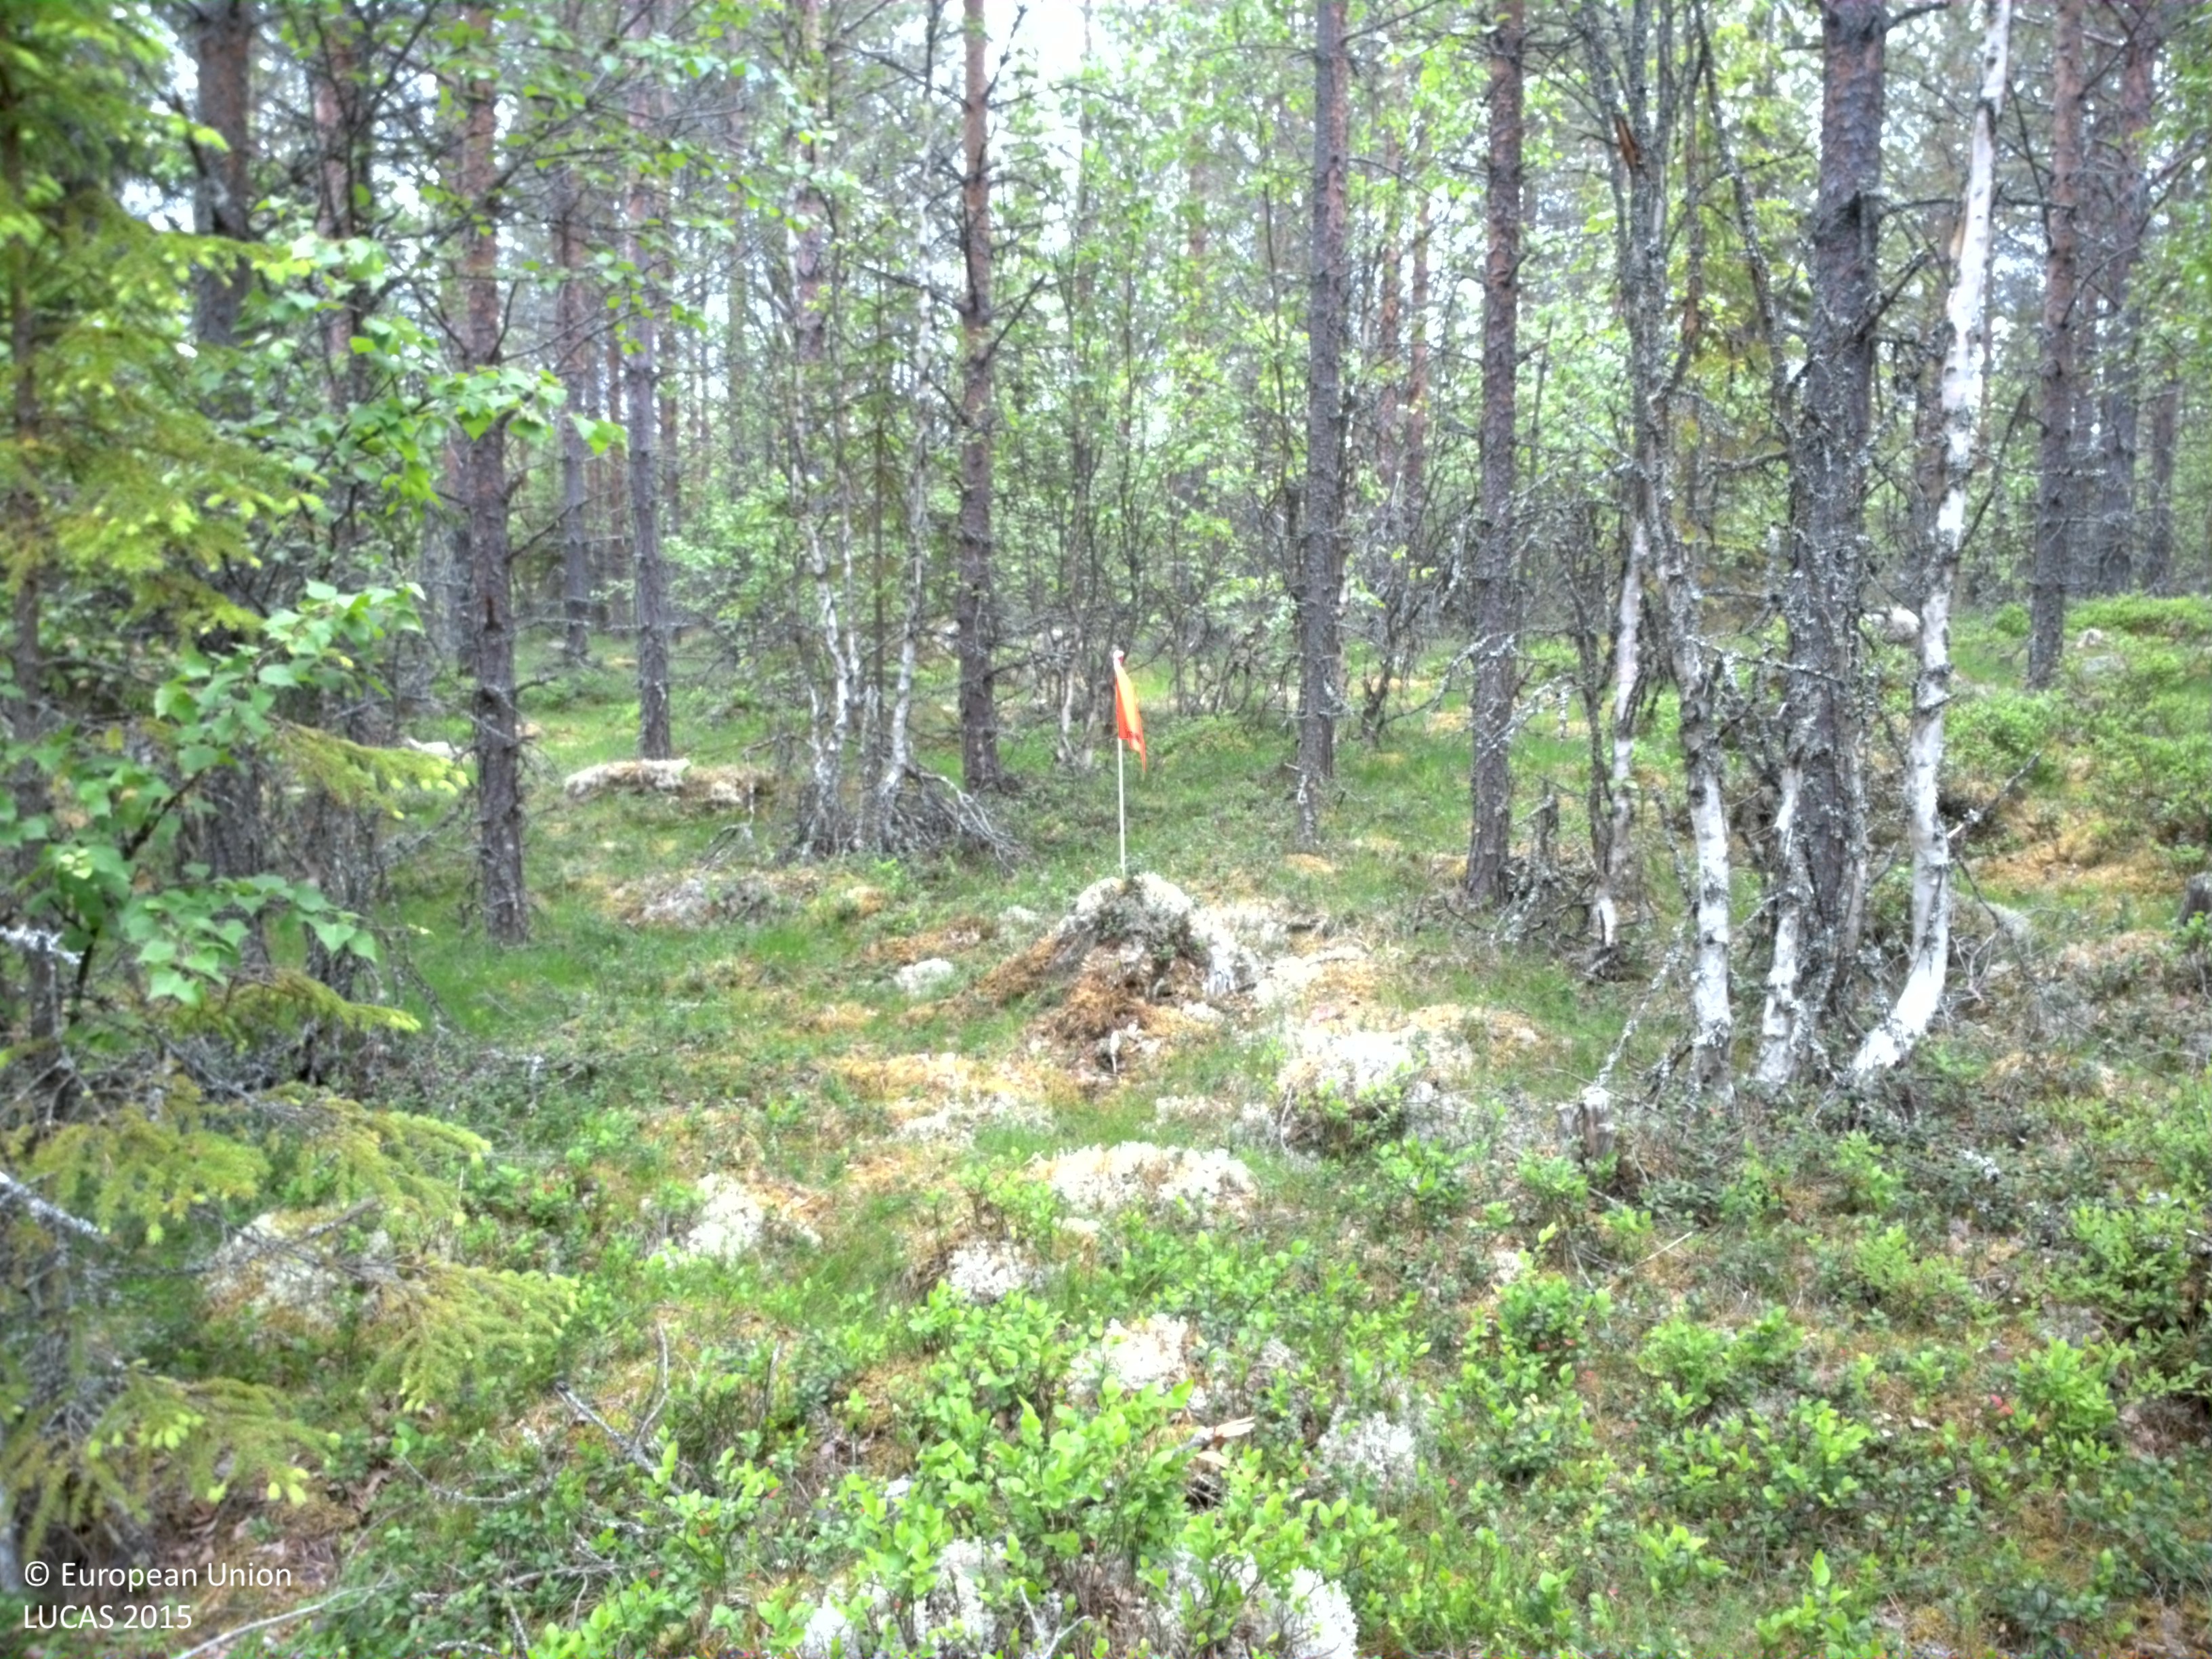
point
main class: Woodland
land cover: Pine dominated mixed woodland
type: boreal forest
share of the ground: 50 - 75 %
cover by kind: coniferous forest trees 50 %, broadleaved forest trees 25 %, lichens and mosses 15 %, herbaceous plants 10 %
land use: Forestry
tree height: > 5 m
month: June
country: SE
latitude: 61.1610
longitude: 13.6490
